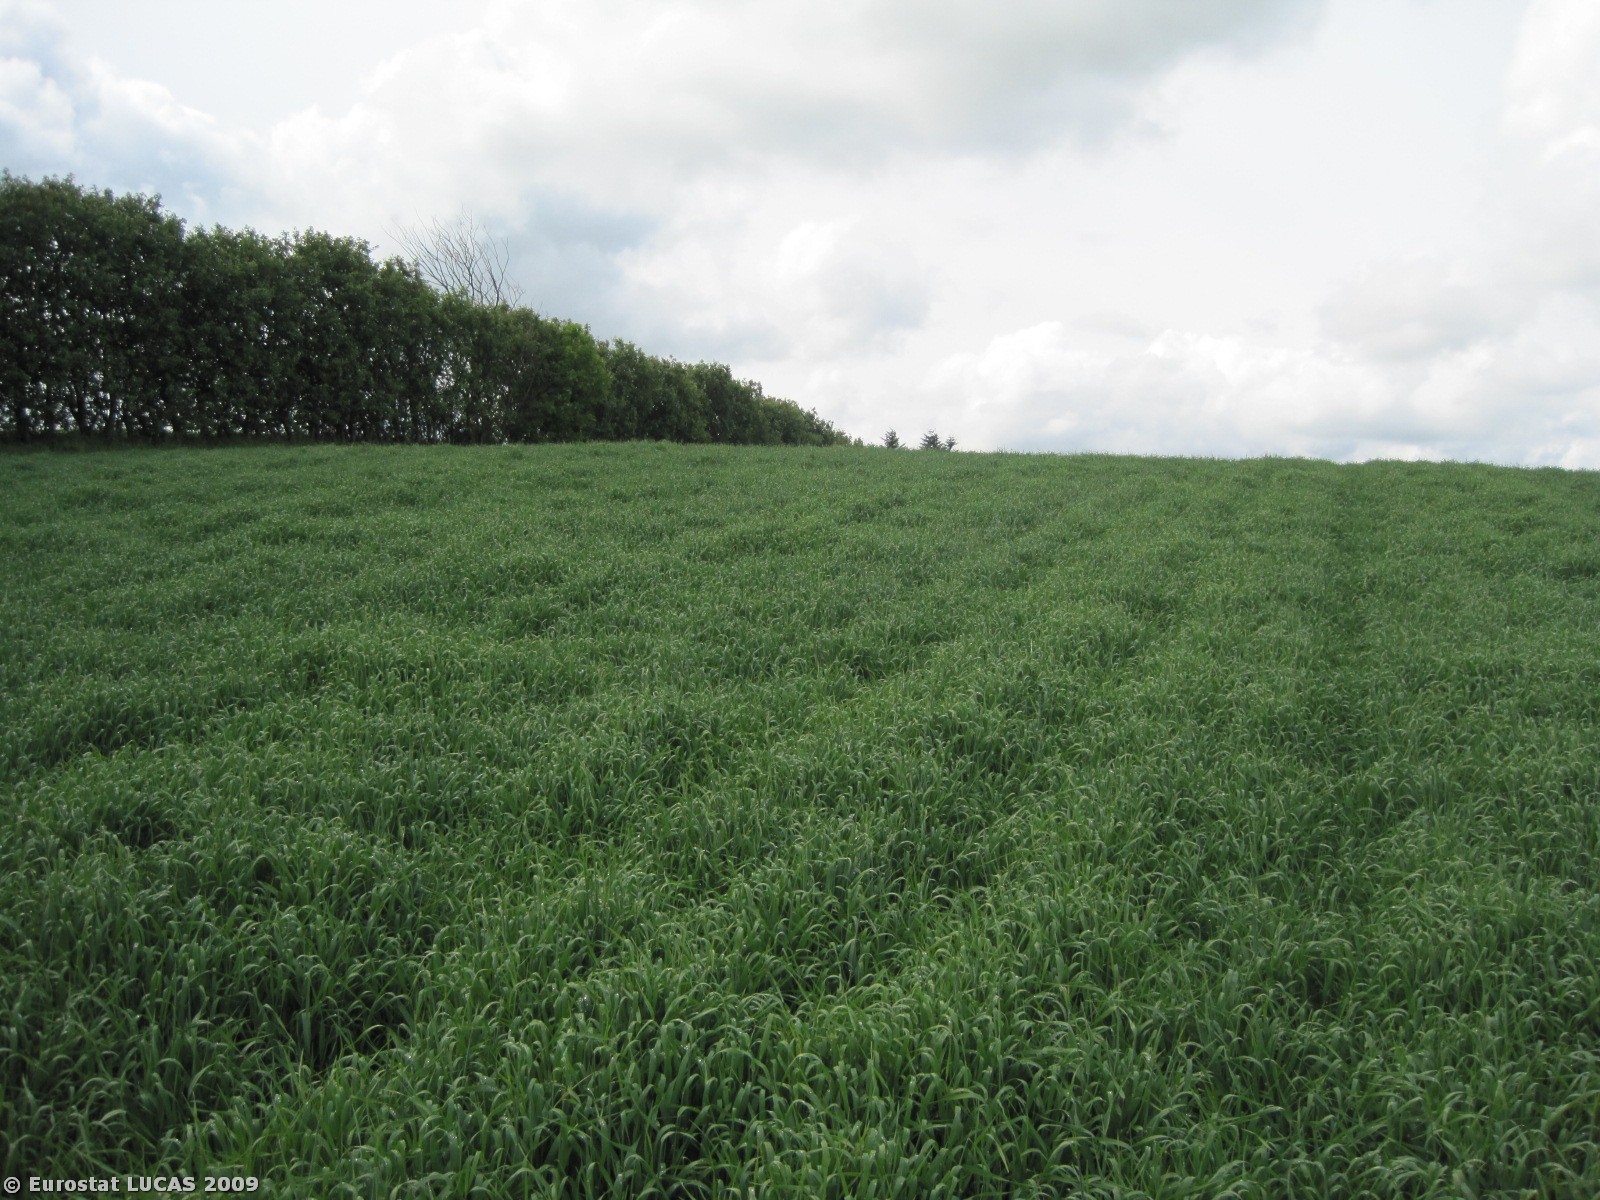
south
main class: Cropland
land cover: Barley
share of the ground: > 75 %
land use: Agriculture (excluding fallow land and kitchen gardens)
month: June
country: DK
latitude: 57.2844
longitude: 10.0166
